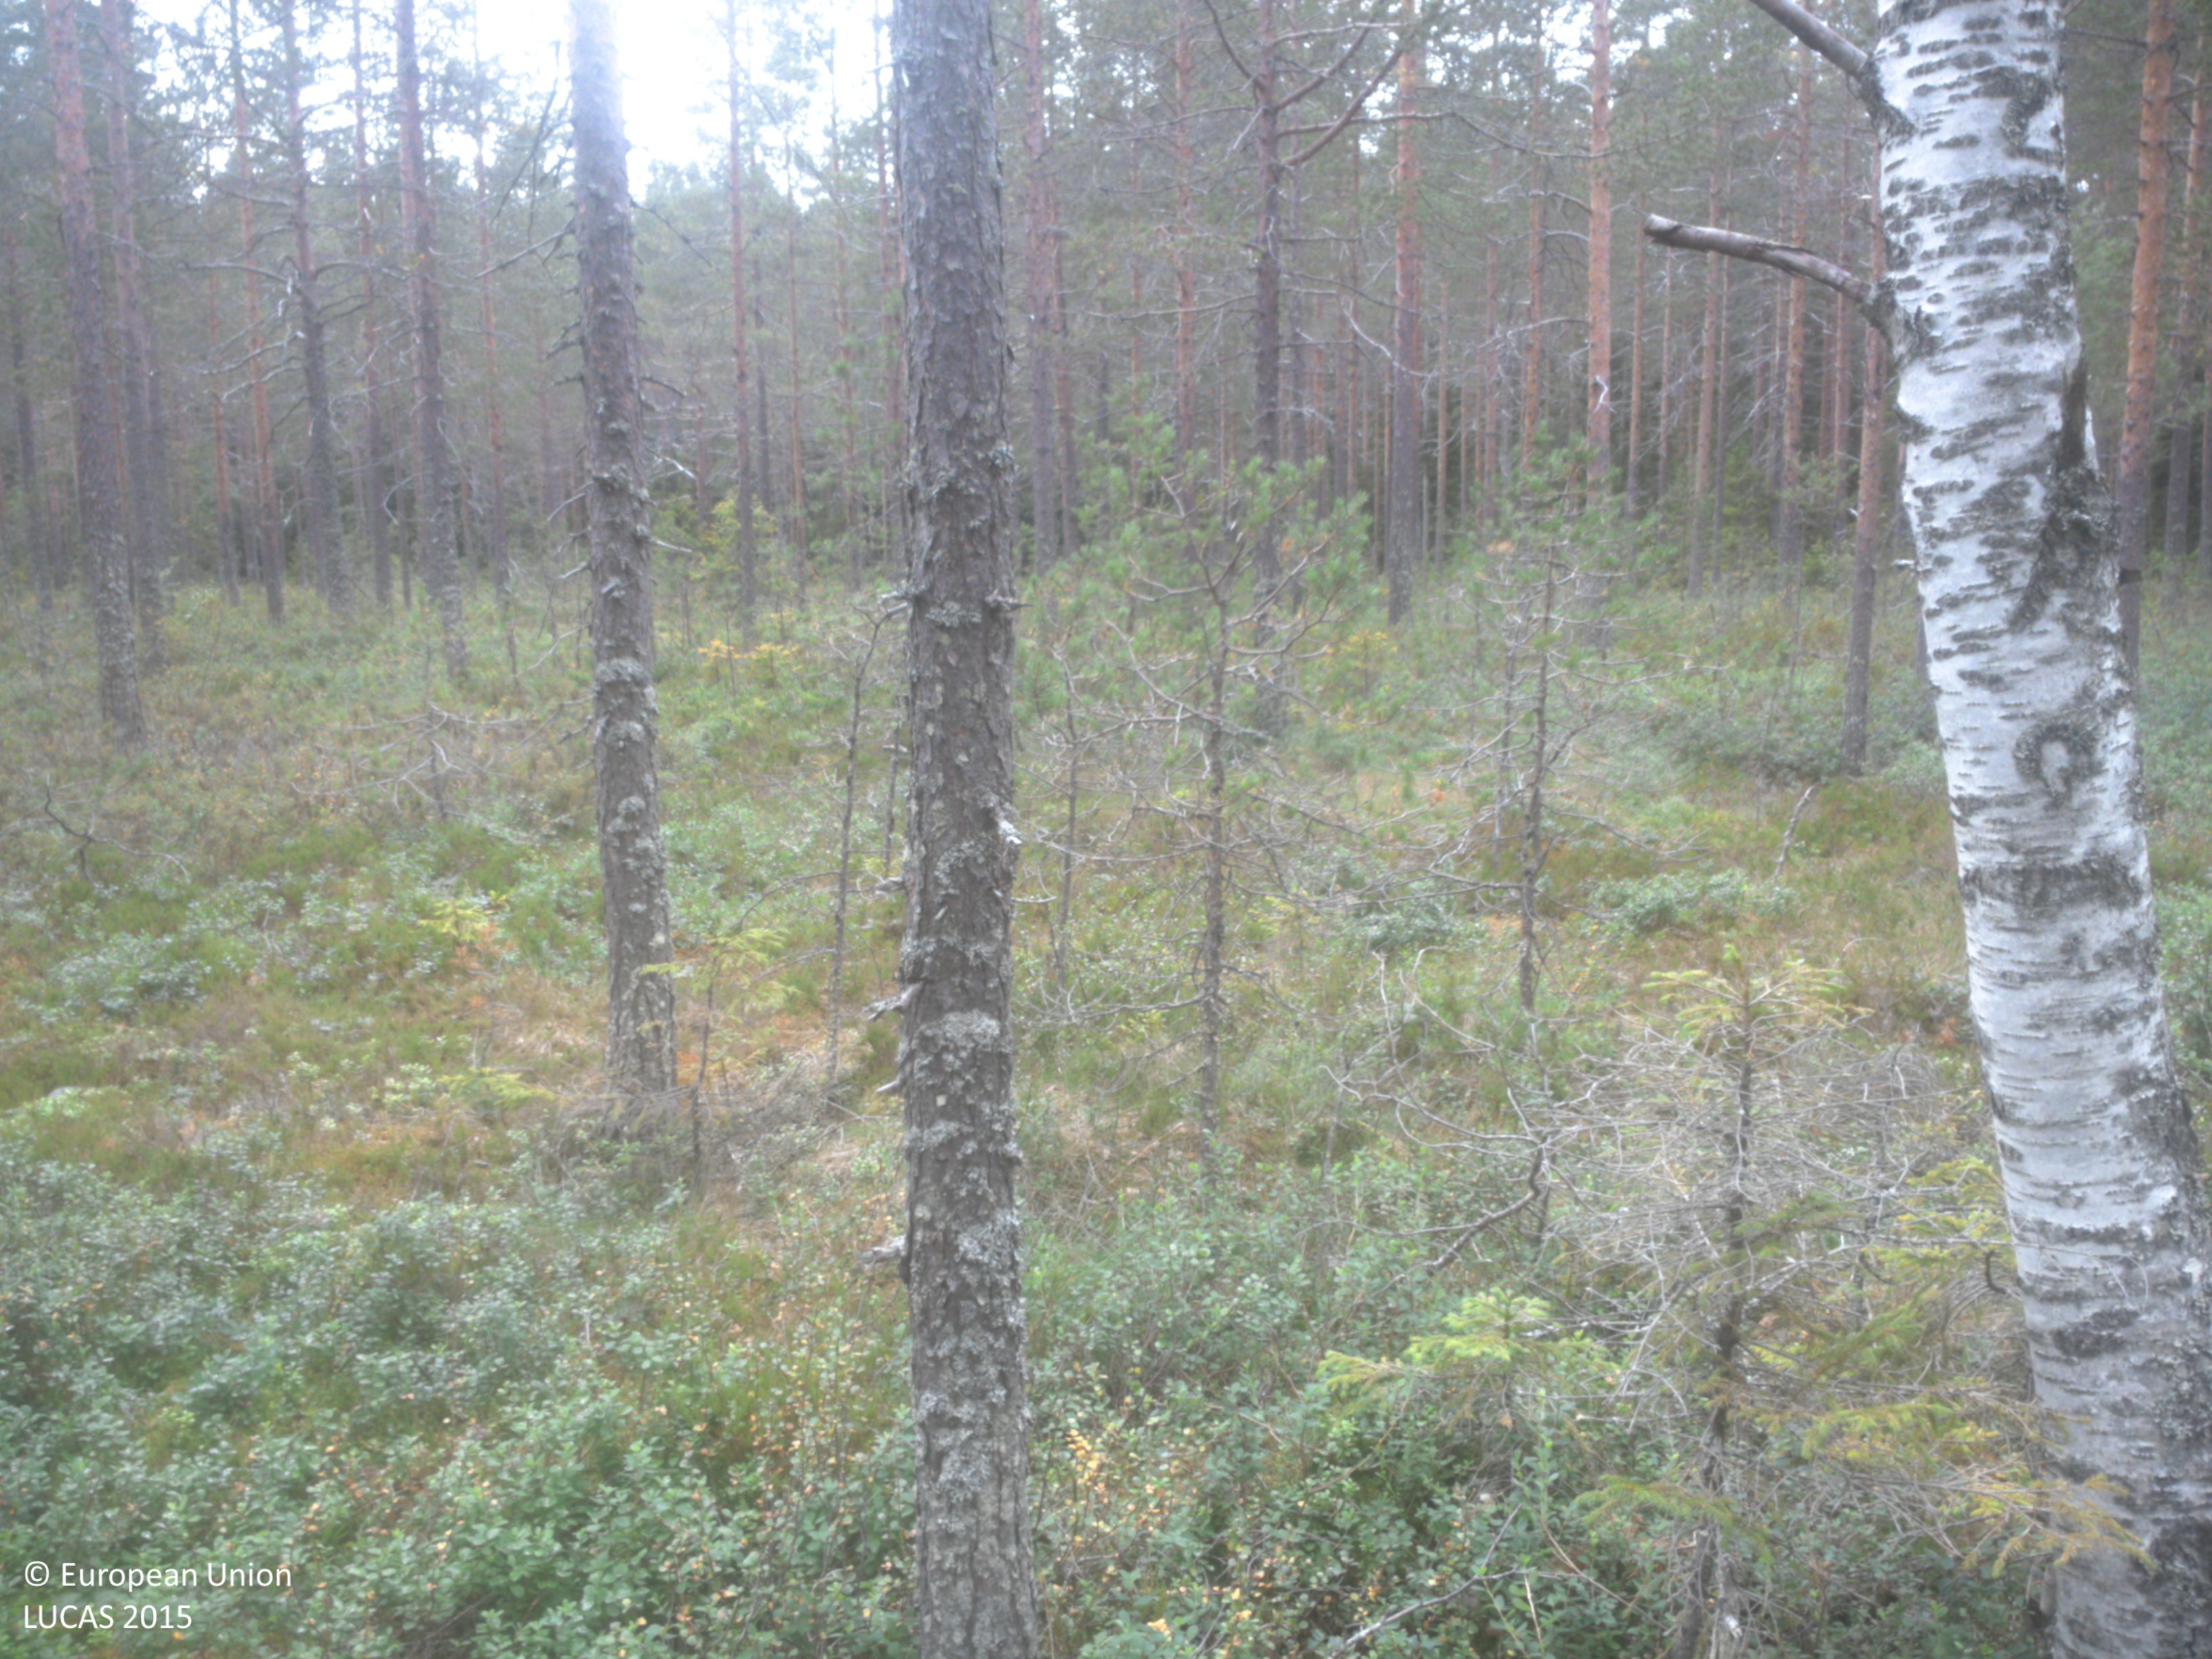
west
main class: Woodland
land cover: Pine dominated mixed woodland
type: boreal forest
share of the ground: 50 - 75 %
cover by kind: shrubs 45 %, coniferous forest trees 30 %, broadleaved forest trees 20 %, lichens and mosses 5 %
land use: Forestry
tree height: > 5 m
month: August
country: SE
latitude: 63.7225
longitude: 19.9210
